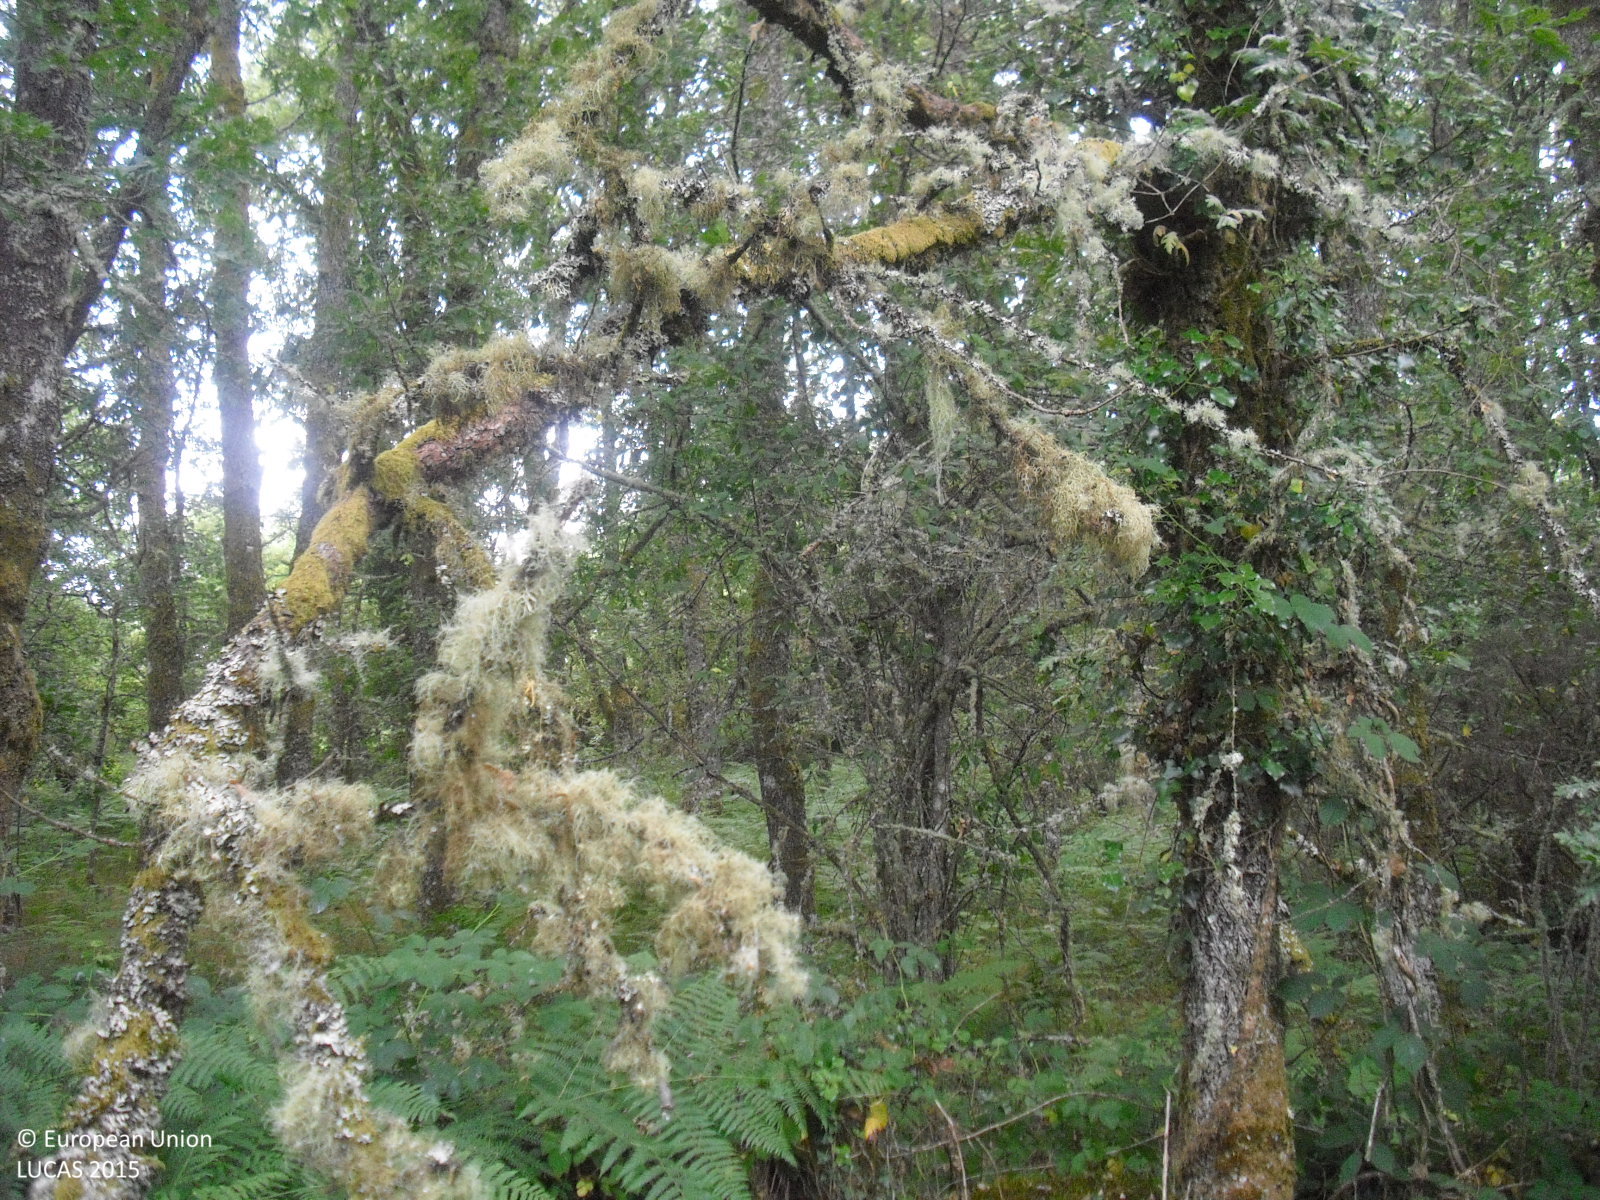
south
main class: Woodland
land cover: Broadleaved woodland
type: thermophilous deciduous forest
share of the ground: 50 - 75 %
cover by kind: broadleaved forest trees 60 %, shrubs 40 %
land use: Forestry
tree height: < 5 m
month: July
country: ES
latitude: 42.3403
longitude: -7.4592
